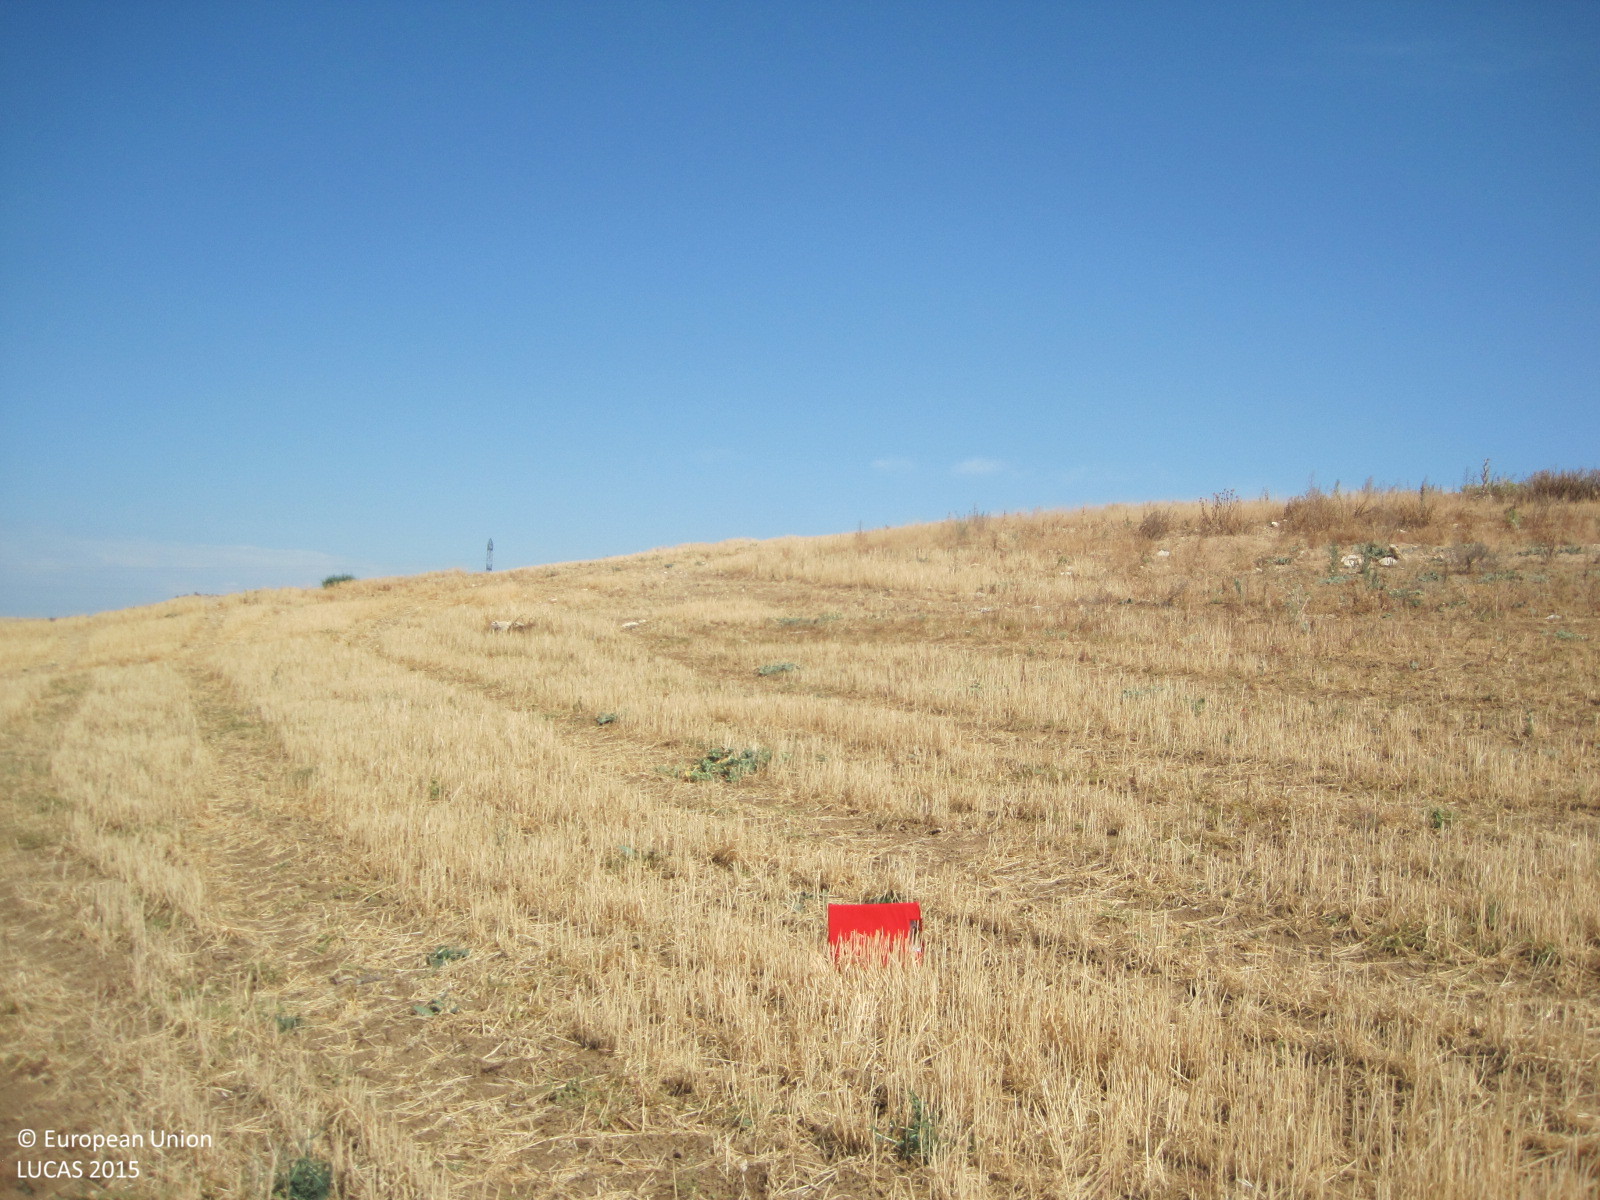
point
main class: Cropland
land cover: Barley
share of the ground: < 10 %
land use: Agriculture (excluding fallow land and kitchen gardens)
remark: Harvested field
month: July
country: ES
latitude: 40.0099
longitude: -4.2499
